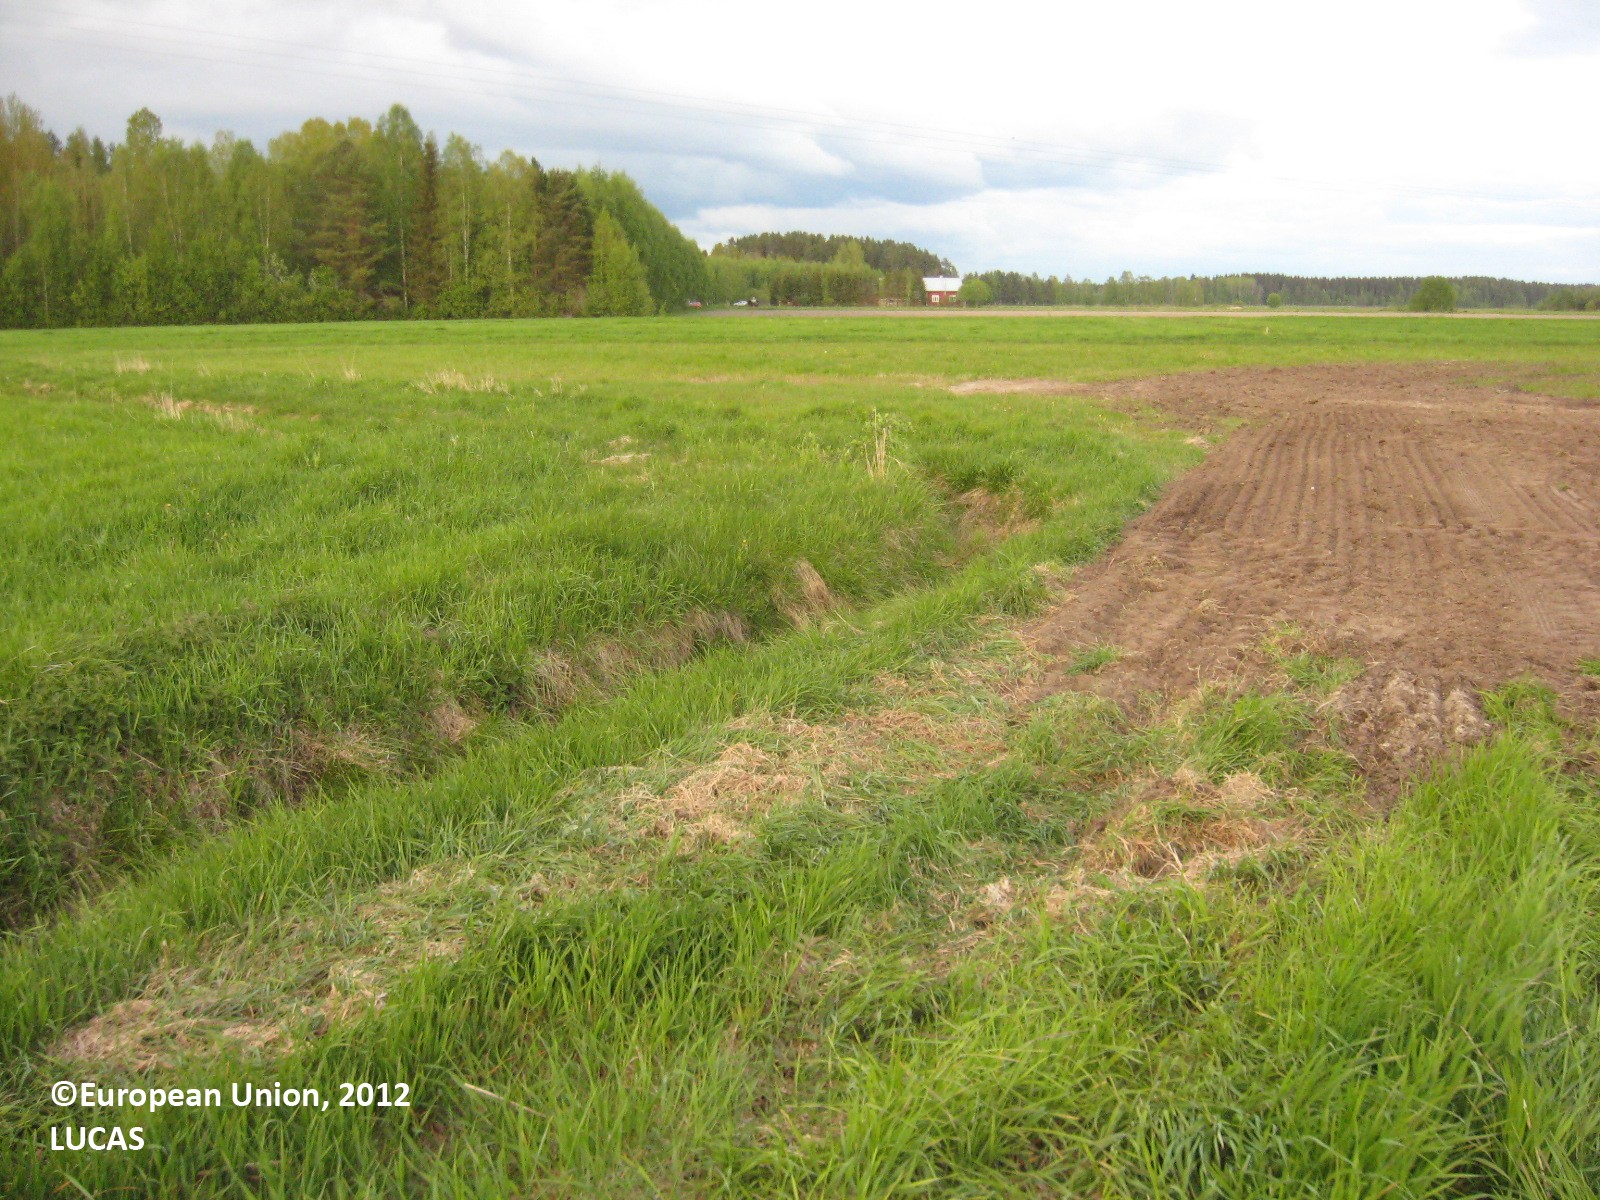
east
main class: Grassland
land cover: Grassland without tree/shrub cover
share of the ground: > 75 %
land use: Agriculture (excluding fallow land and kitchen gardens)
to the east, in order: Grassland without tree/shrub cover; Ditches and canals; Grassland without tree/shrub cover; Ditches and canals; Temporary grasslands; Ditches and canals; Temporary grasslands; Electric lines; Temporary grasslands; Spontaneously vegetated surfaces; Ditches and canals; Other mixed woodland; Ditches and canals; Broadleaved woodland
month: June
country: FI
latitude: 63.3263
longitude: 22.8118
